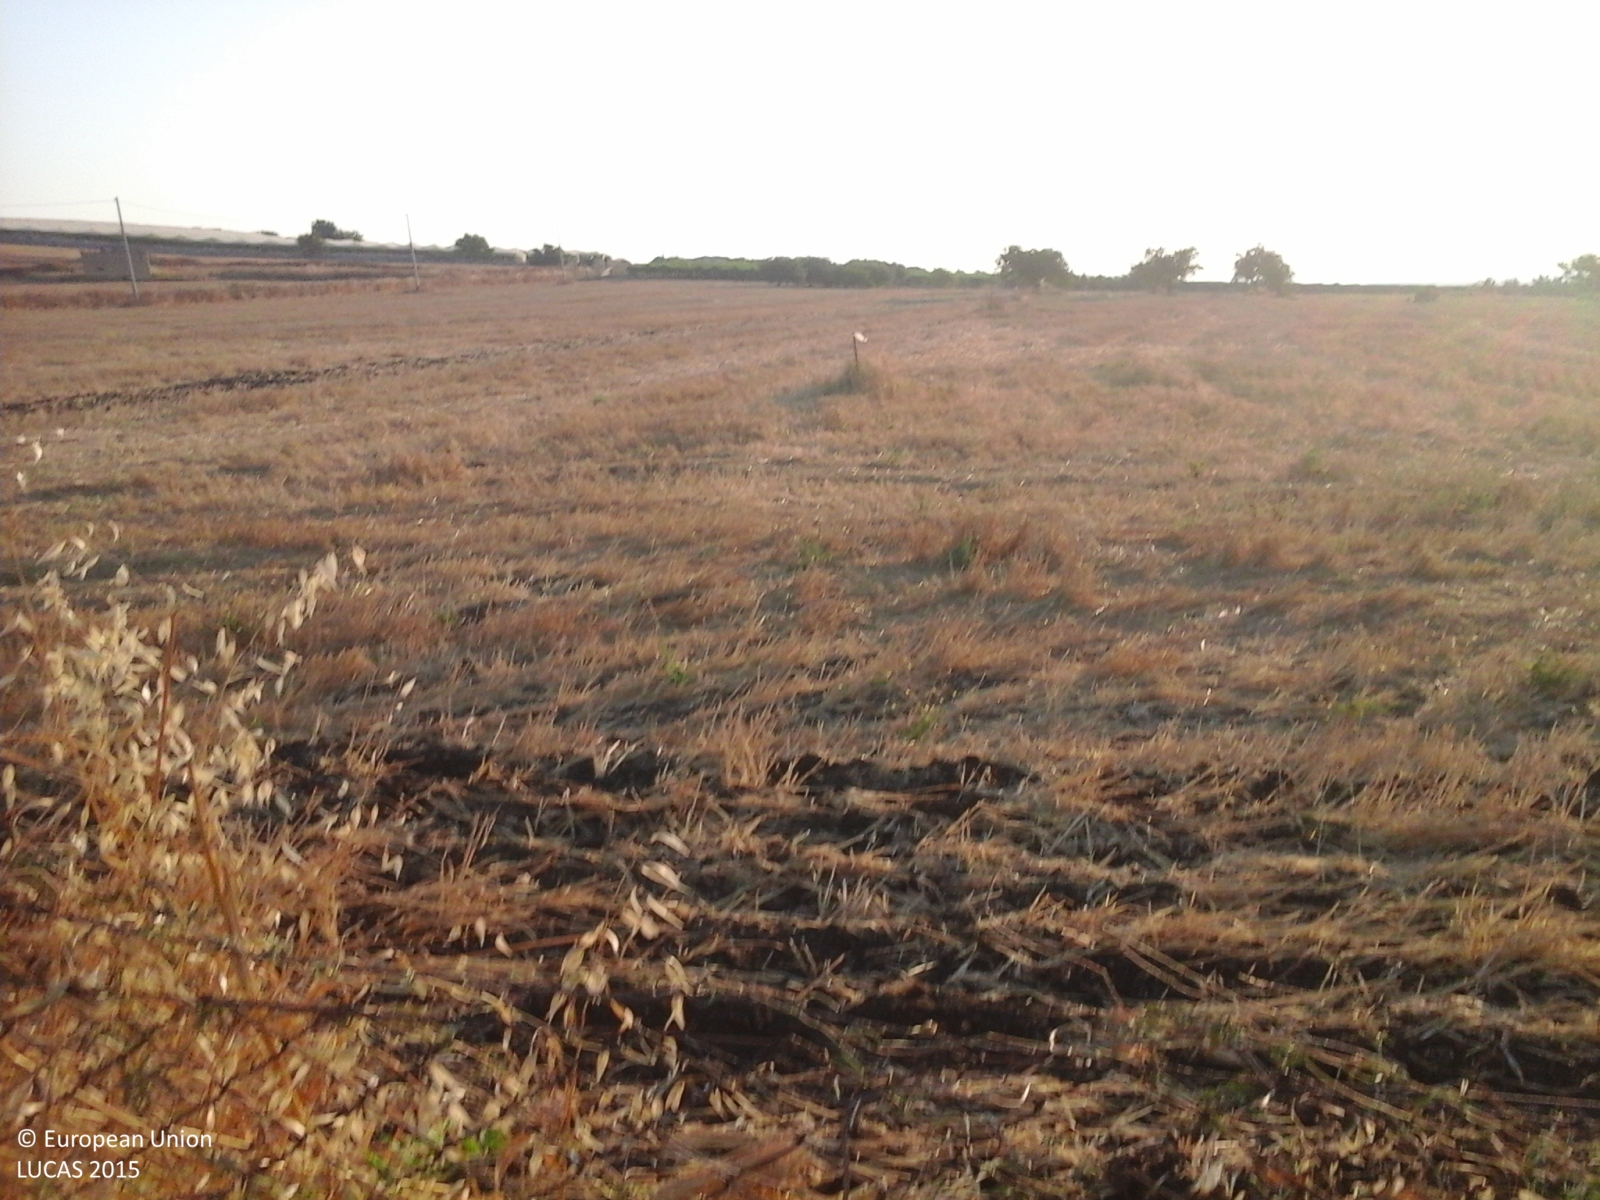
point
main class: Cropland
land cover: Durum wheat
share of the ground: > 75 %
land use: Agriculture (excluding fallow land and kitchen gardens)
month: July
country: IT
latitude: 37.1893
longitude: 14.0351
